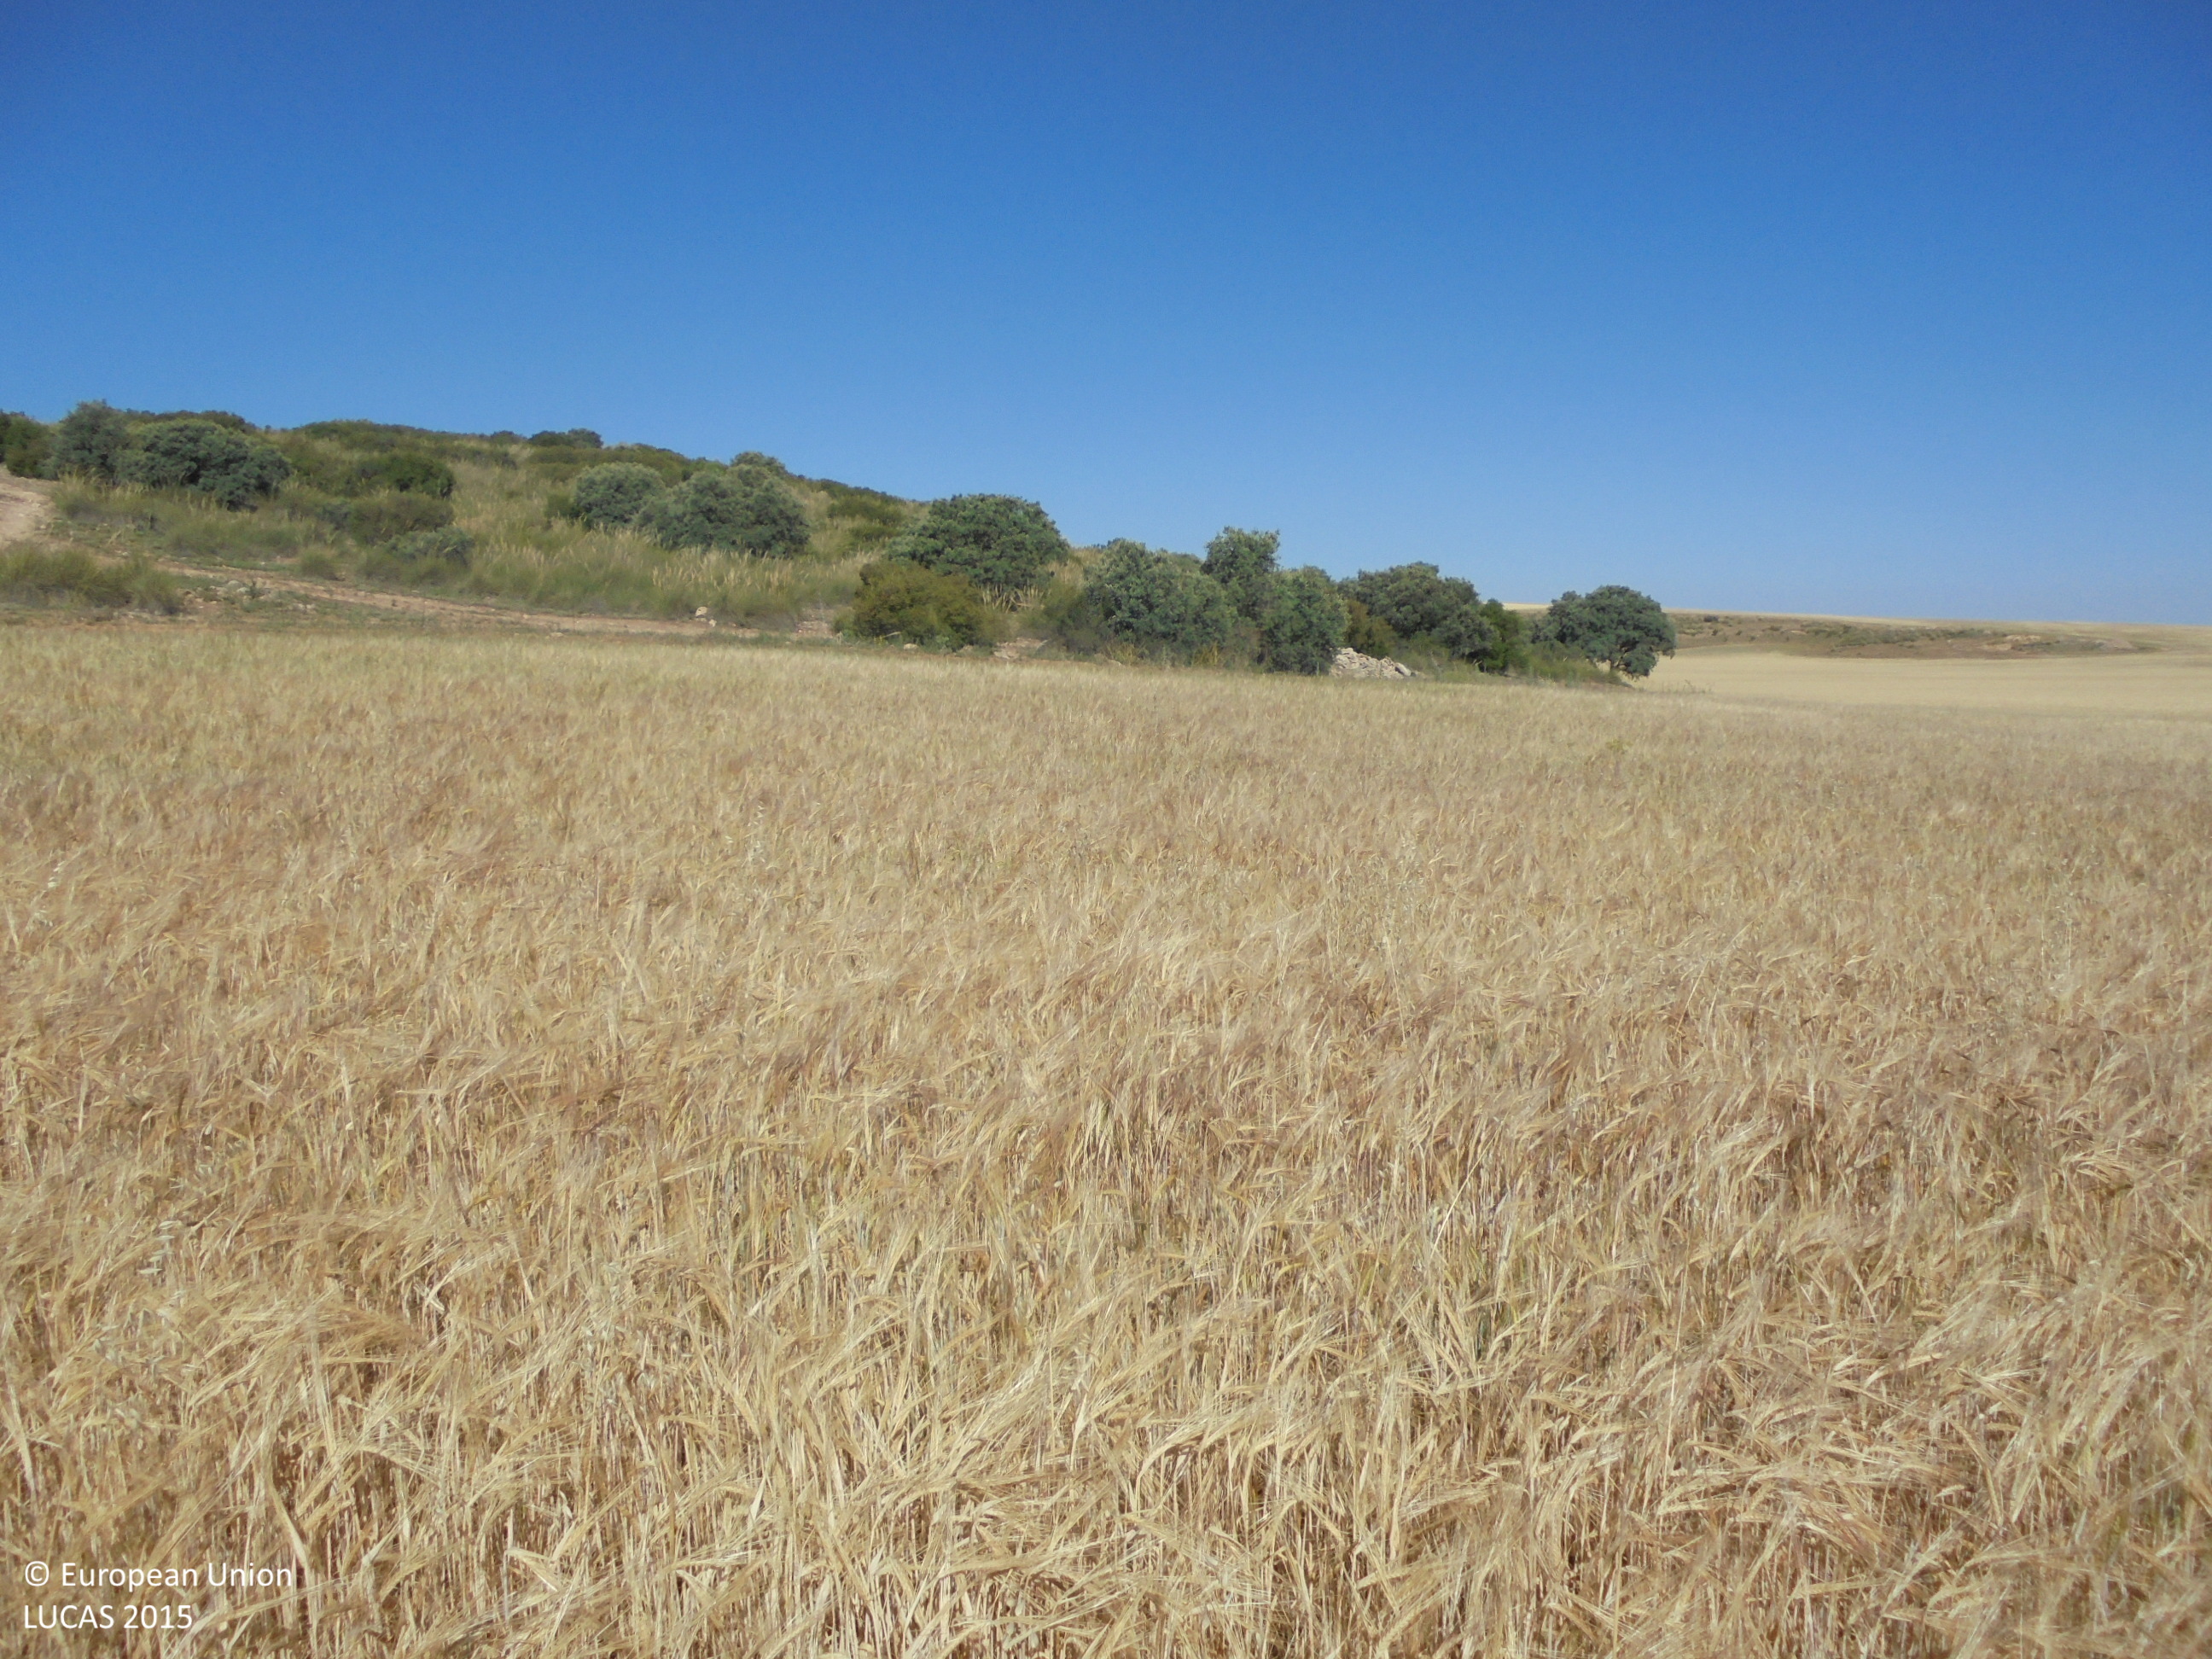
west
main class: Cropland
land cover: Barley
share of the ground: > 75 %
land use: Agriculture (excluding fallow land and kitchen gardens)
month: June
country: ES
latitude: 38.8474
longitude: -1.7387
